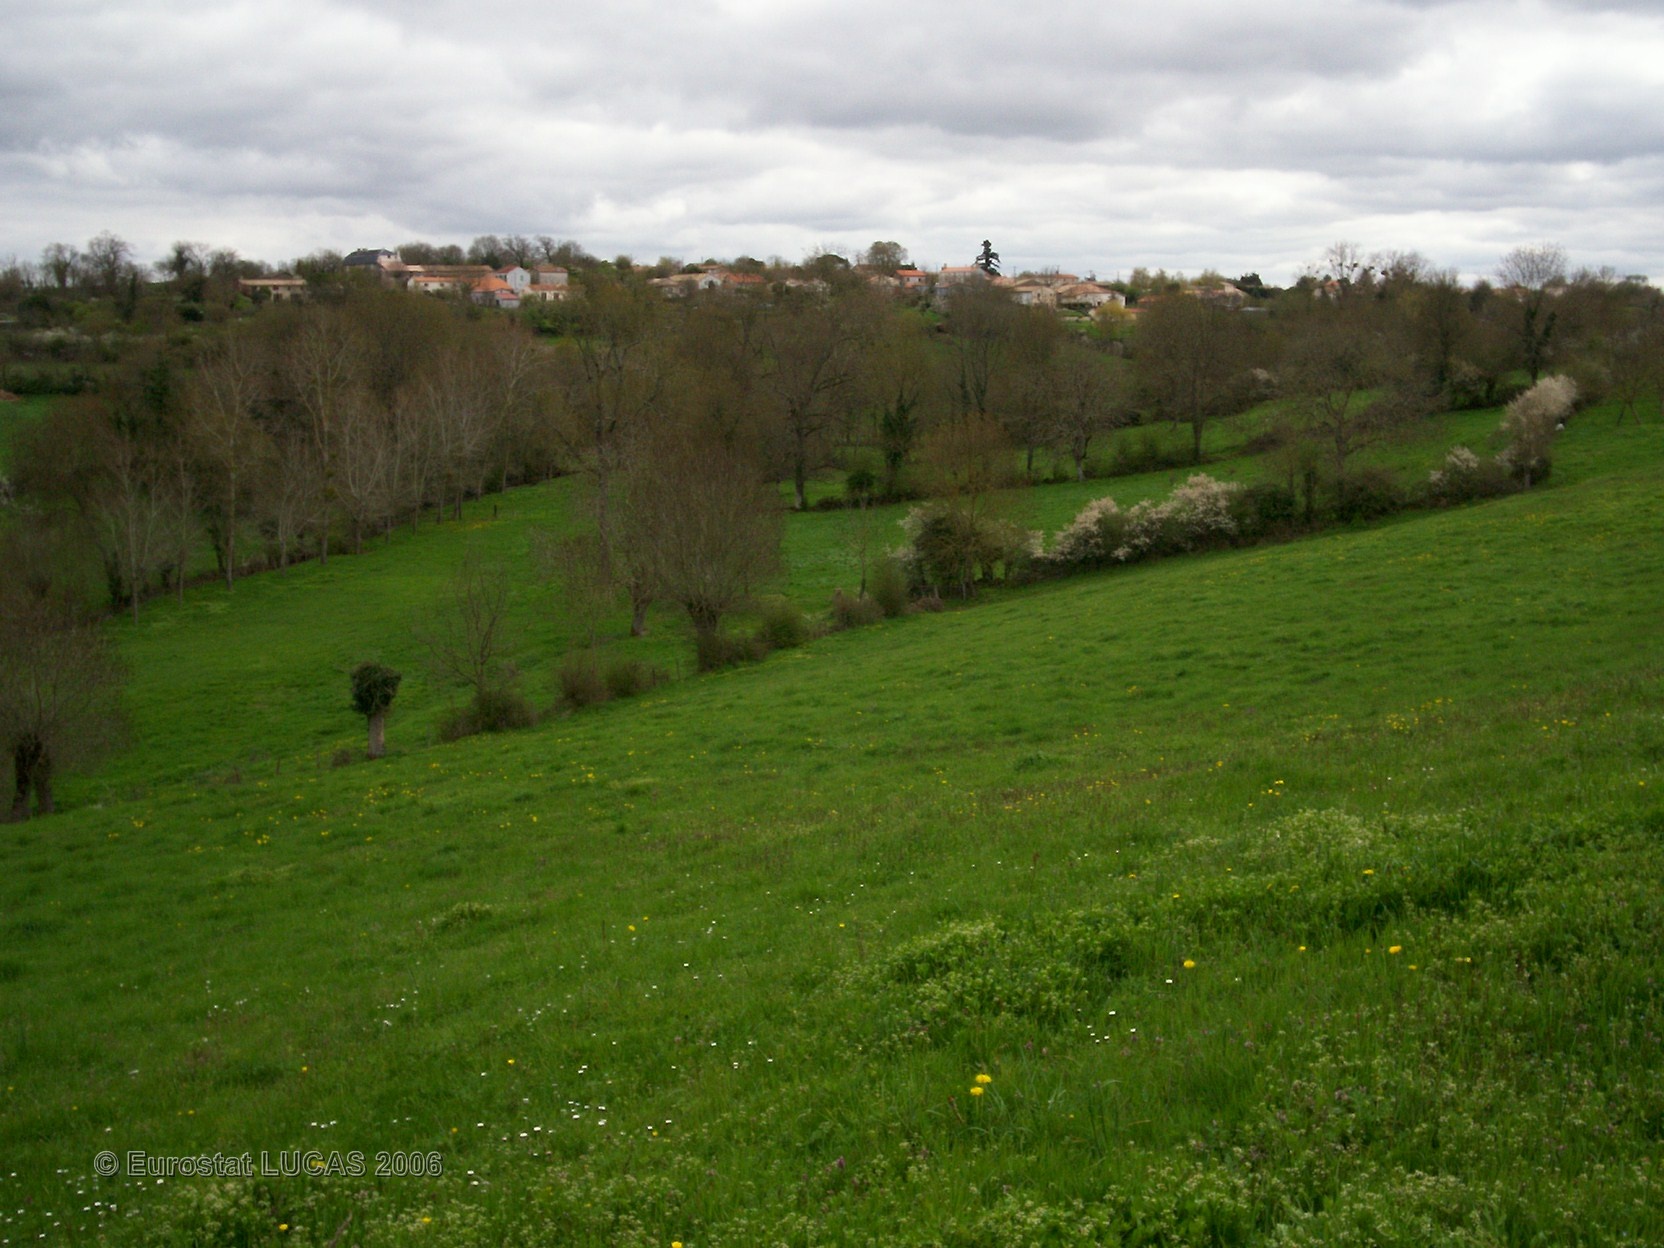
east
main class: Grassland
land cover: Grassland without tree/shrub cover
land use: Agriculture (excluding fallow land and kitchen gardens)
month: April
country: FR
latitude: 46.3095
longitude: -0.2685
